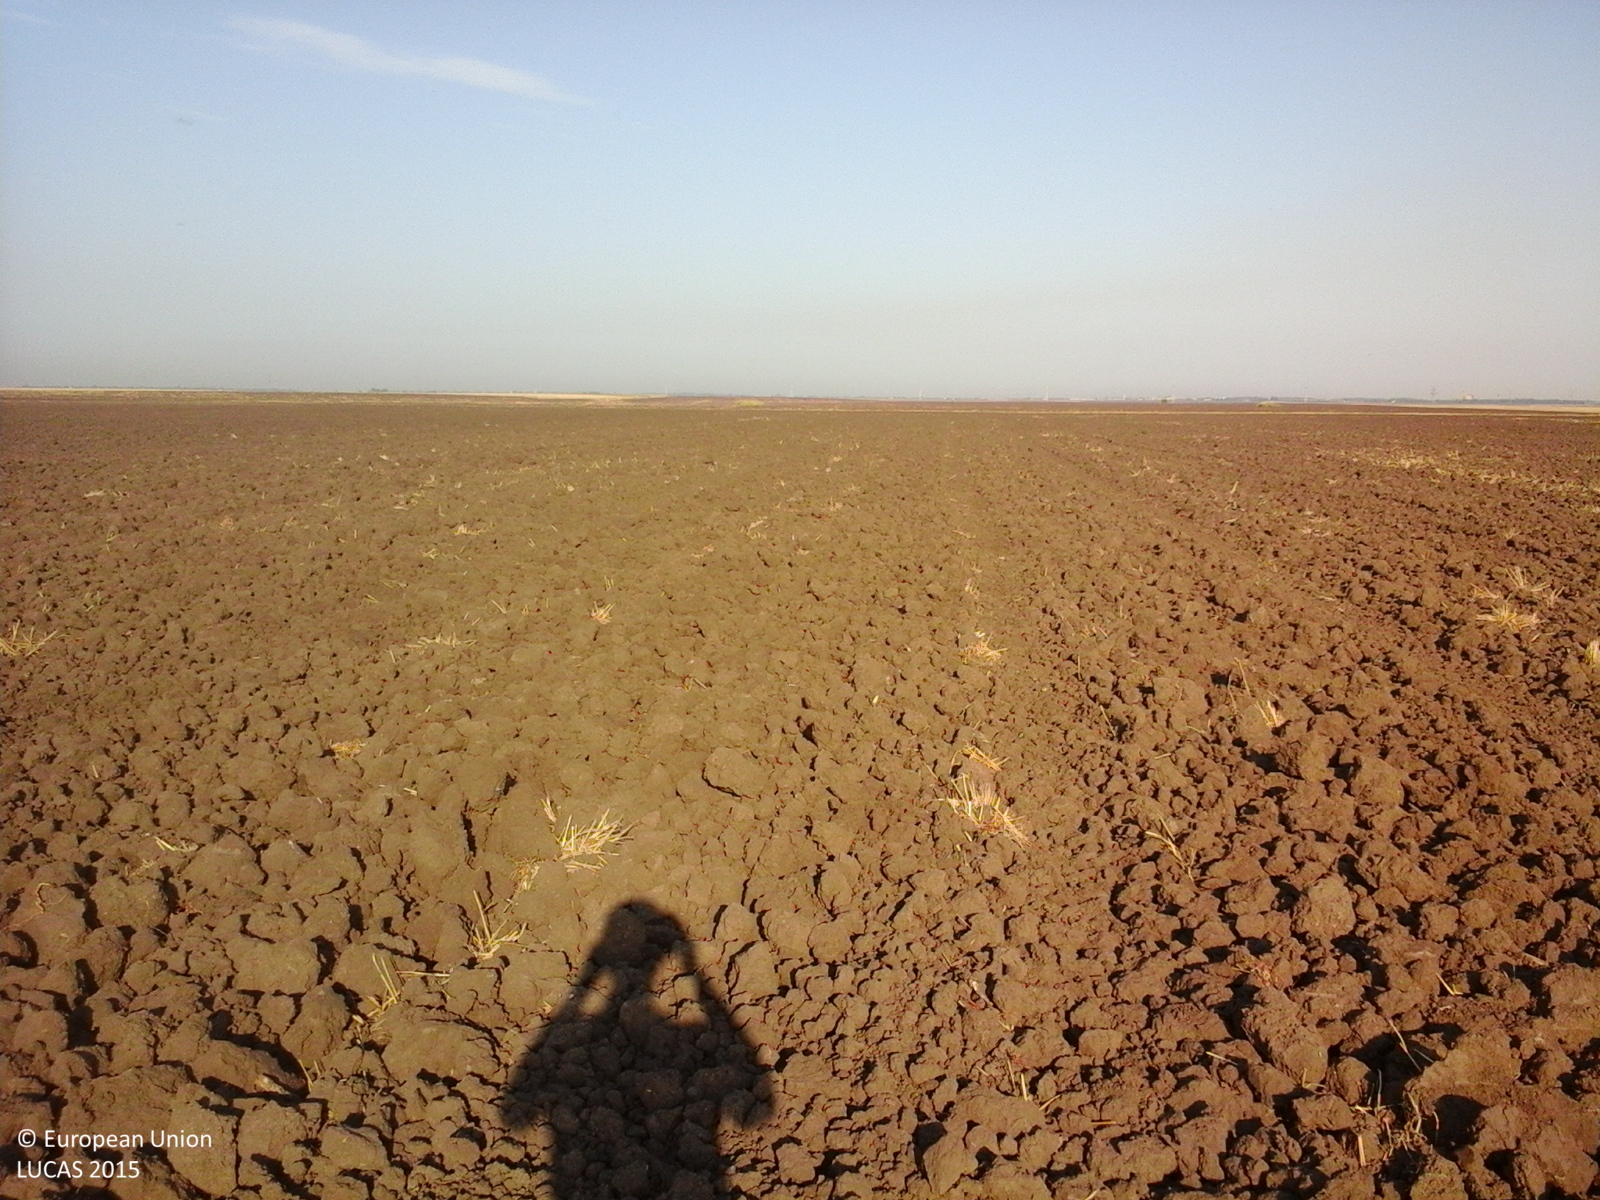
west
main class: Cropland
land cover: Common wheat
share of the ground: < 10 %
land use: Agriculture (excluding fallow land and kitchen gardens)
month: August
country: RO
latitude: 44.0200
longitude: 23.7129
